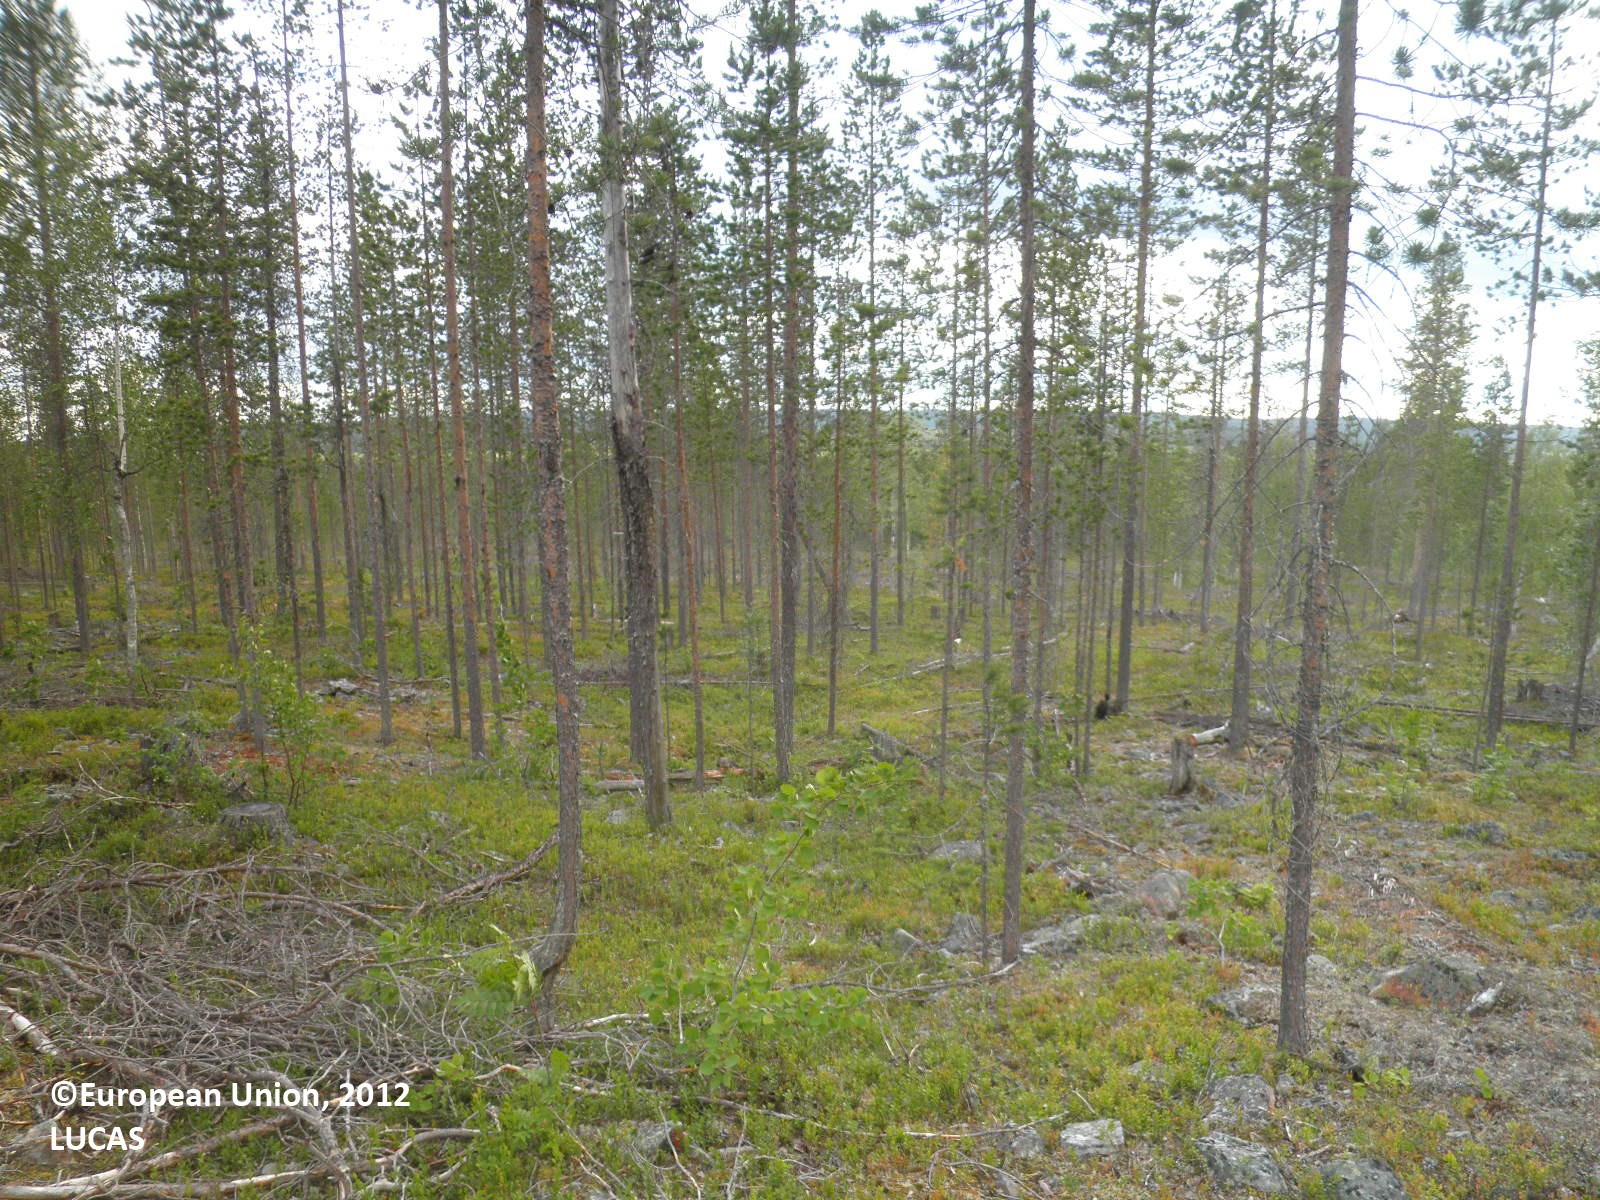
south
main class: Woodland
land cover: Pine dominated coniferous woodland
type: boreal forest
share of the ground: 25 - 50 %
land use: Forestry
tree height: > 5 m
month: July
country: FI
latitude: 67.5282
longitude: 26.0254
